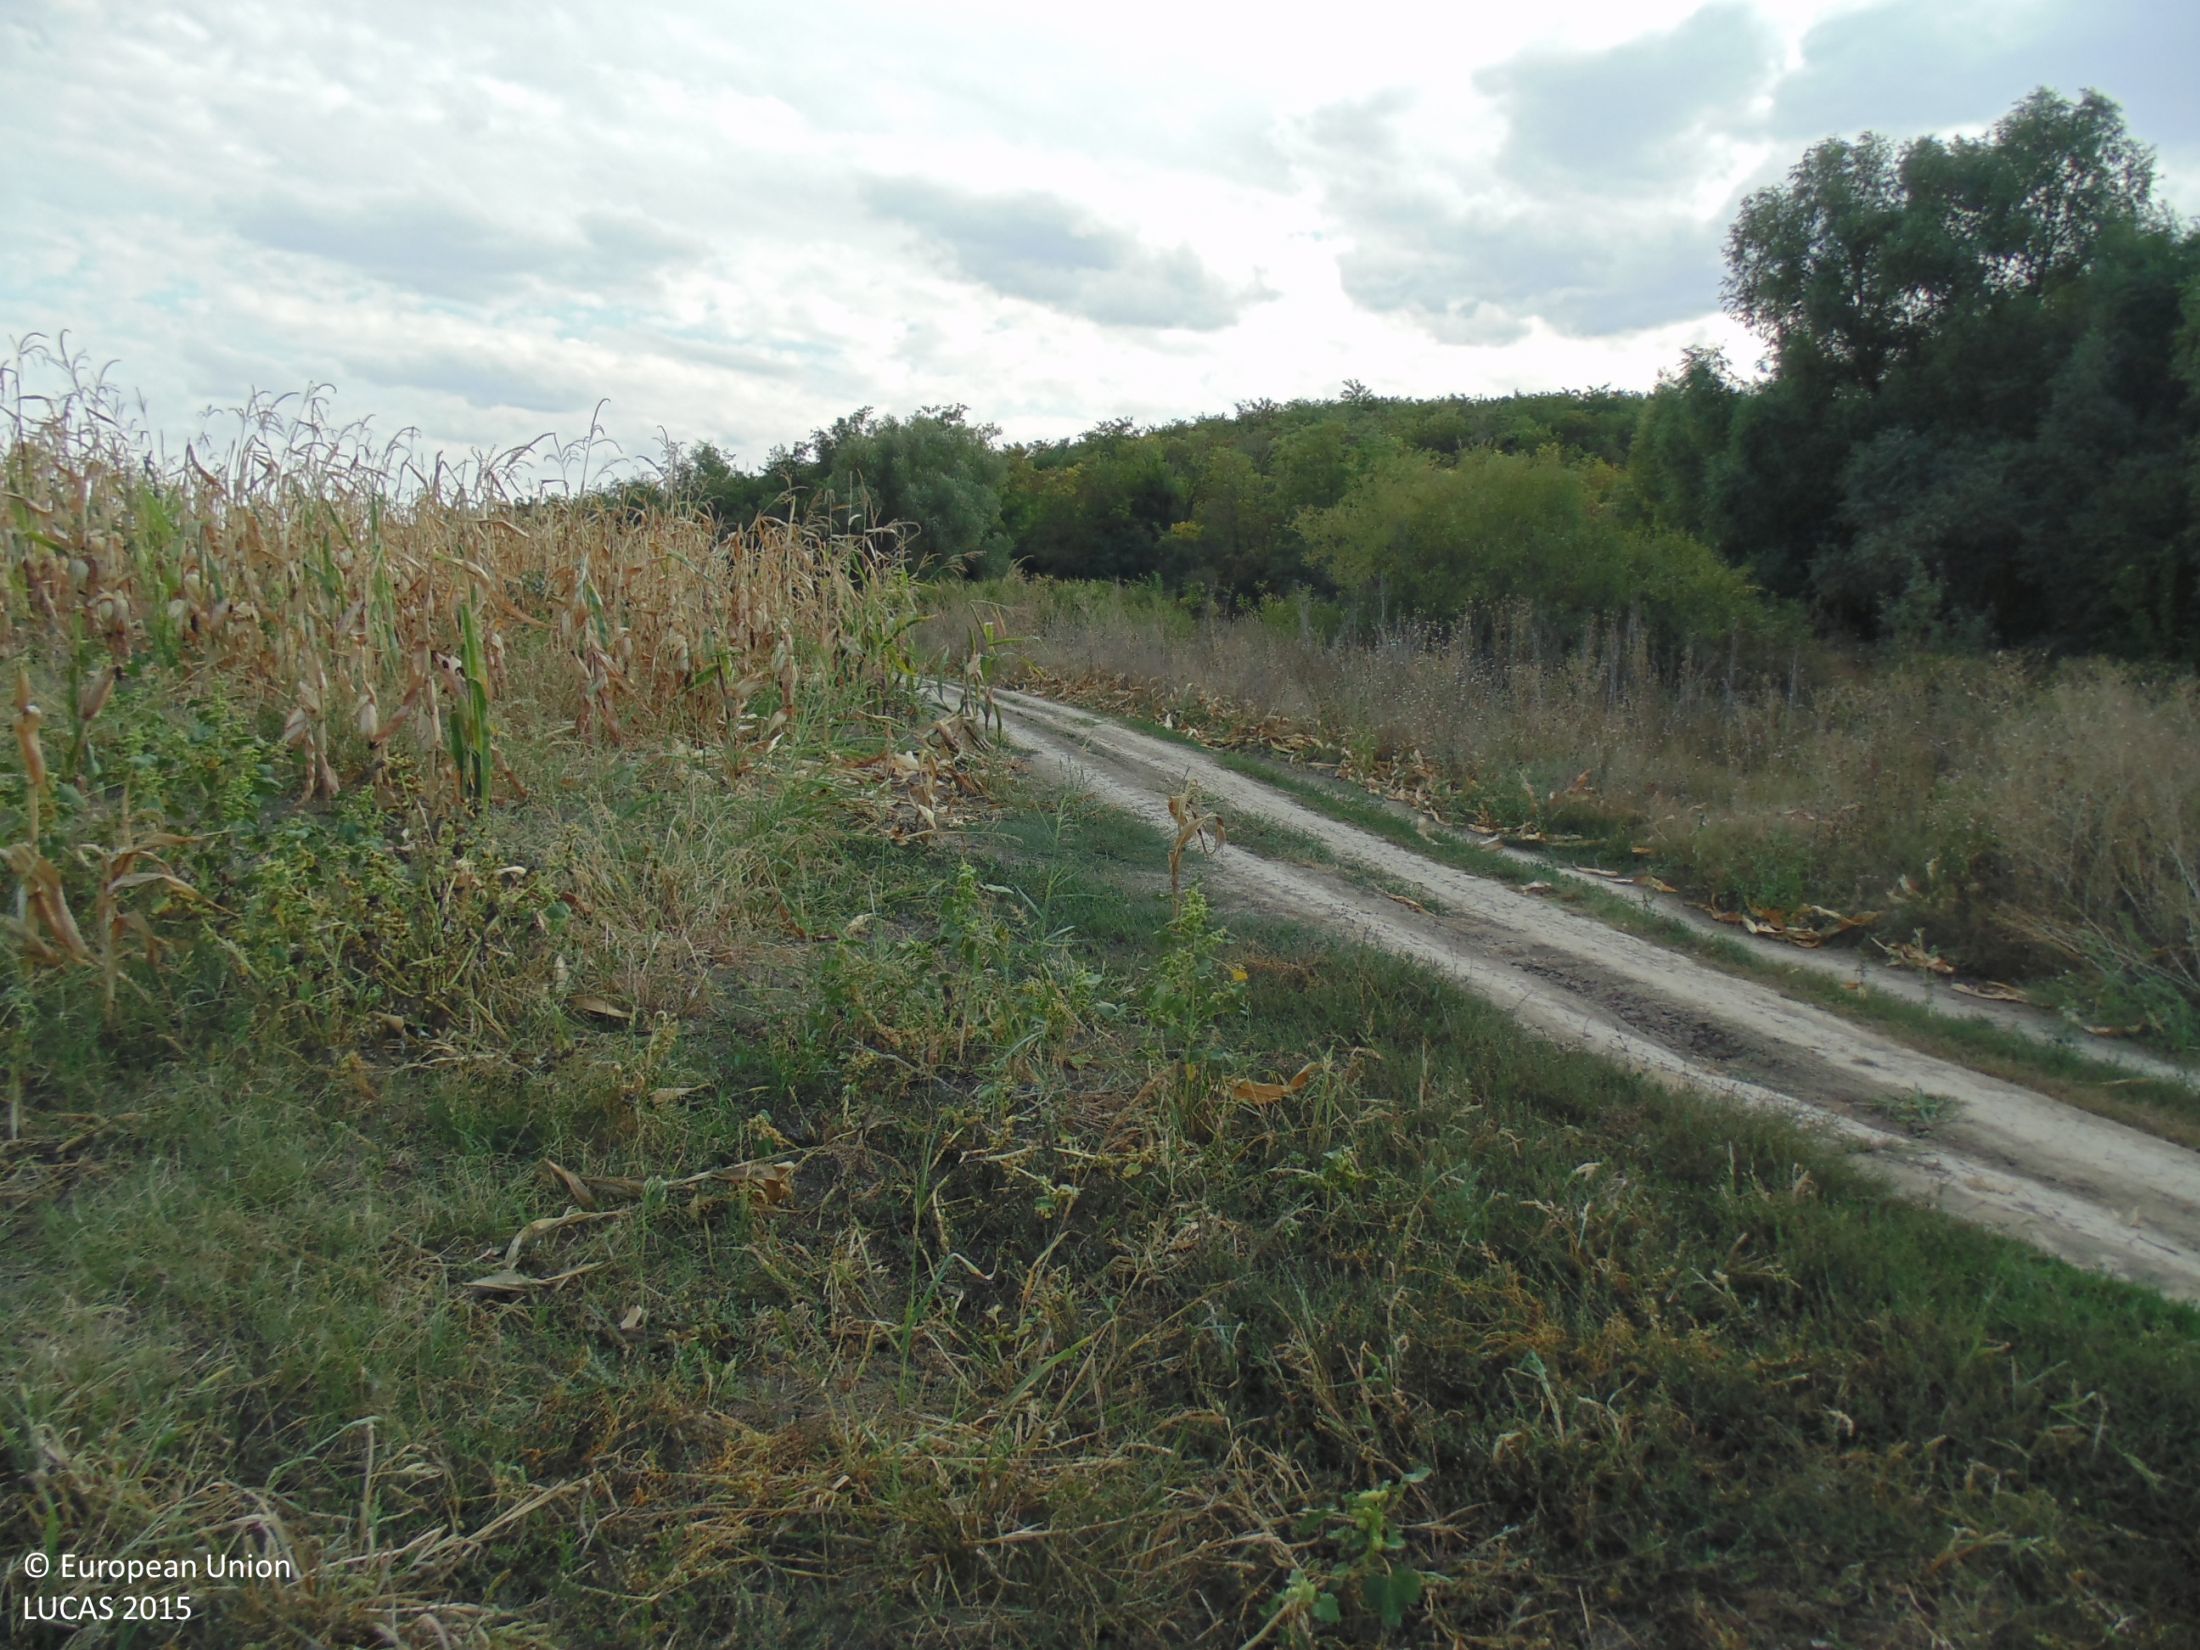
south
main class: Cropland
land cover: Common wheat
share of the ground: < 10 %
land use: Agriculture (excluding fallow land and kitchen gardens)
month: September
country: BG
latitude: 44.0701
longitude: 27.1459
